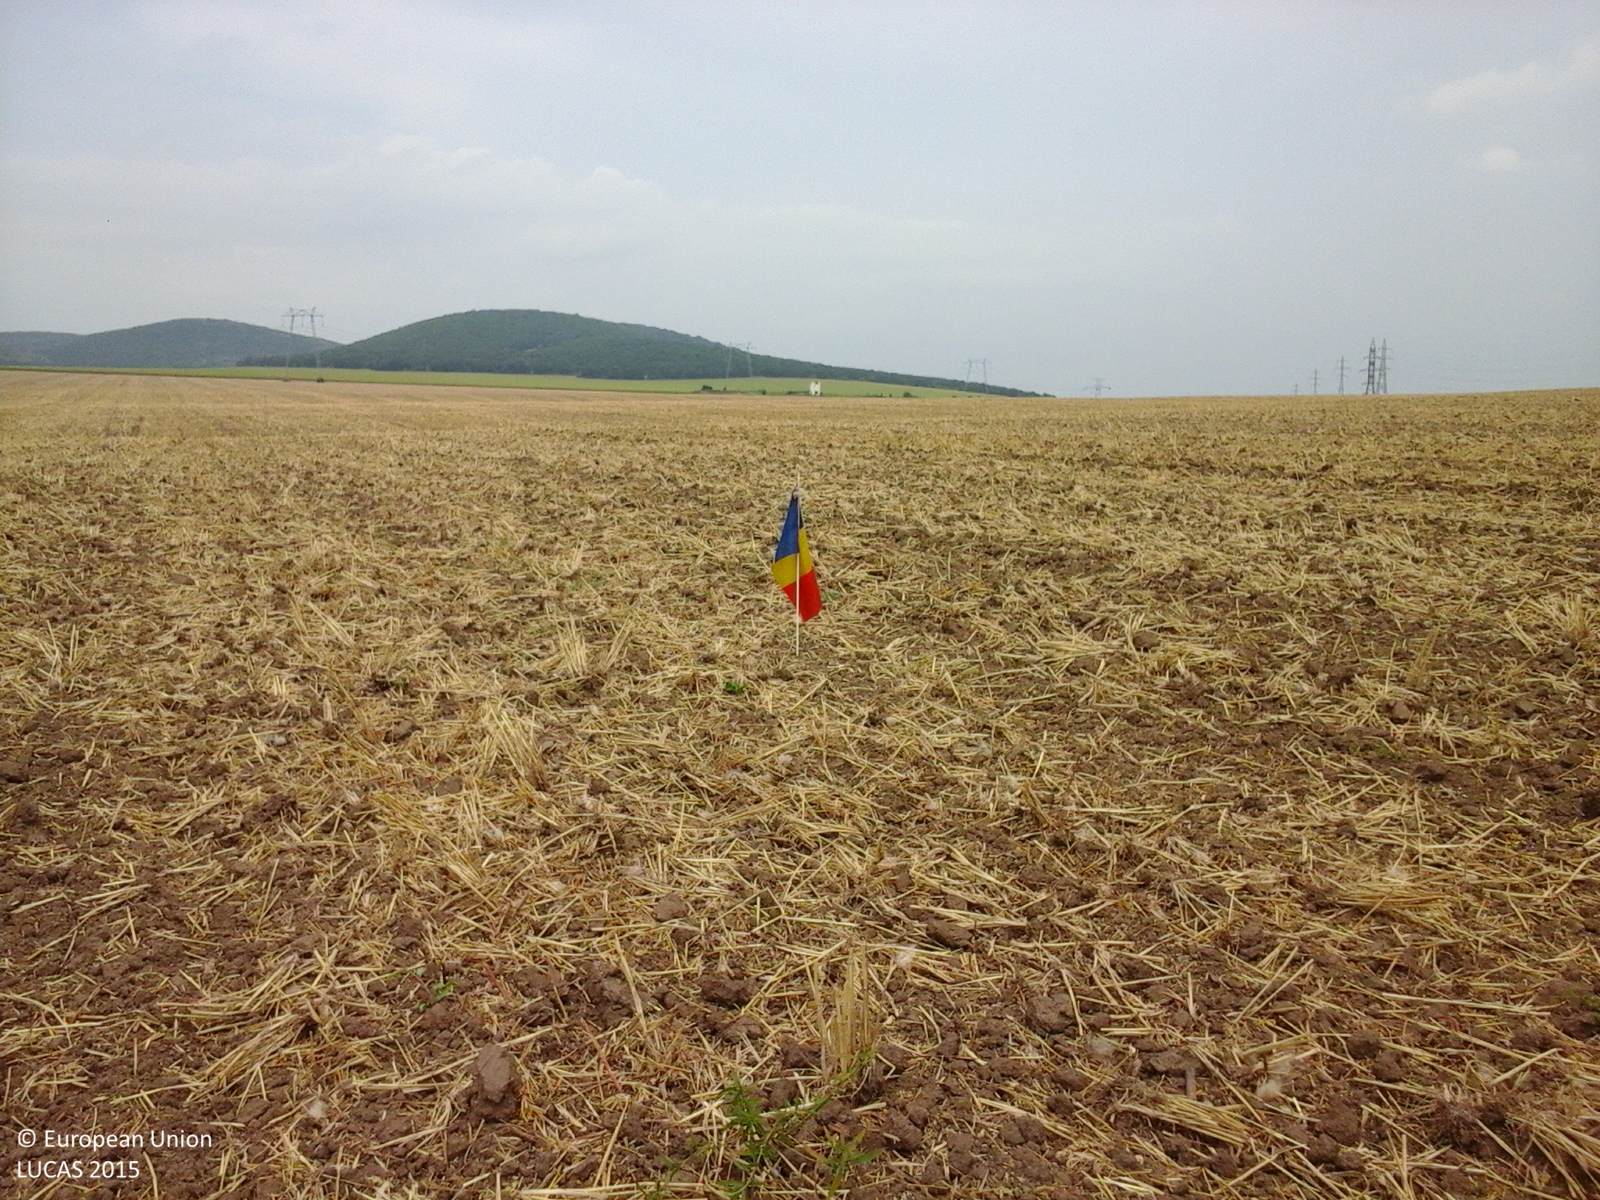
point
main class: Cropland
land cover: Durum wheat
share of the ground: < 10 %
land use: Agriculture (excluding fallow land and kitchen gardens)
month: July
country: RO
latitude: 44.9024
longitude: 28.6088
